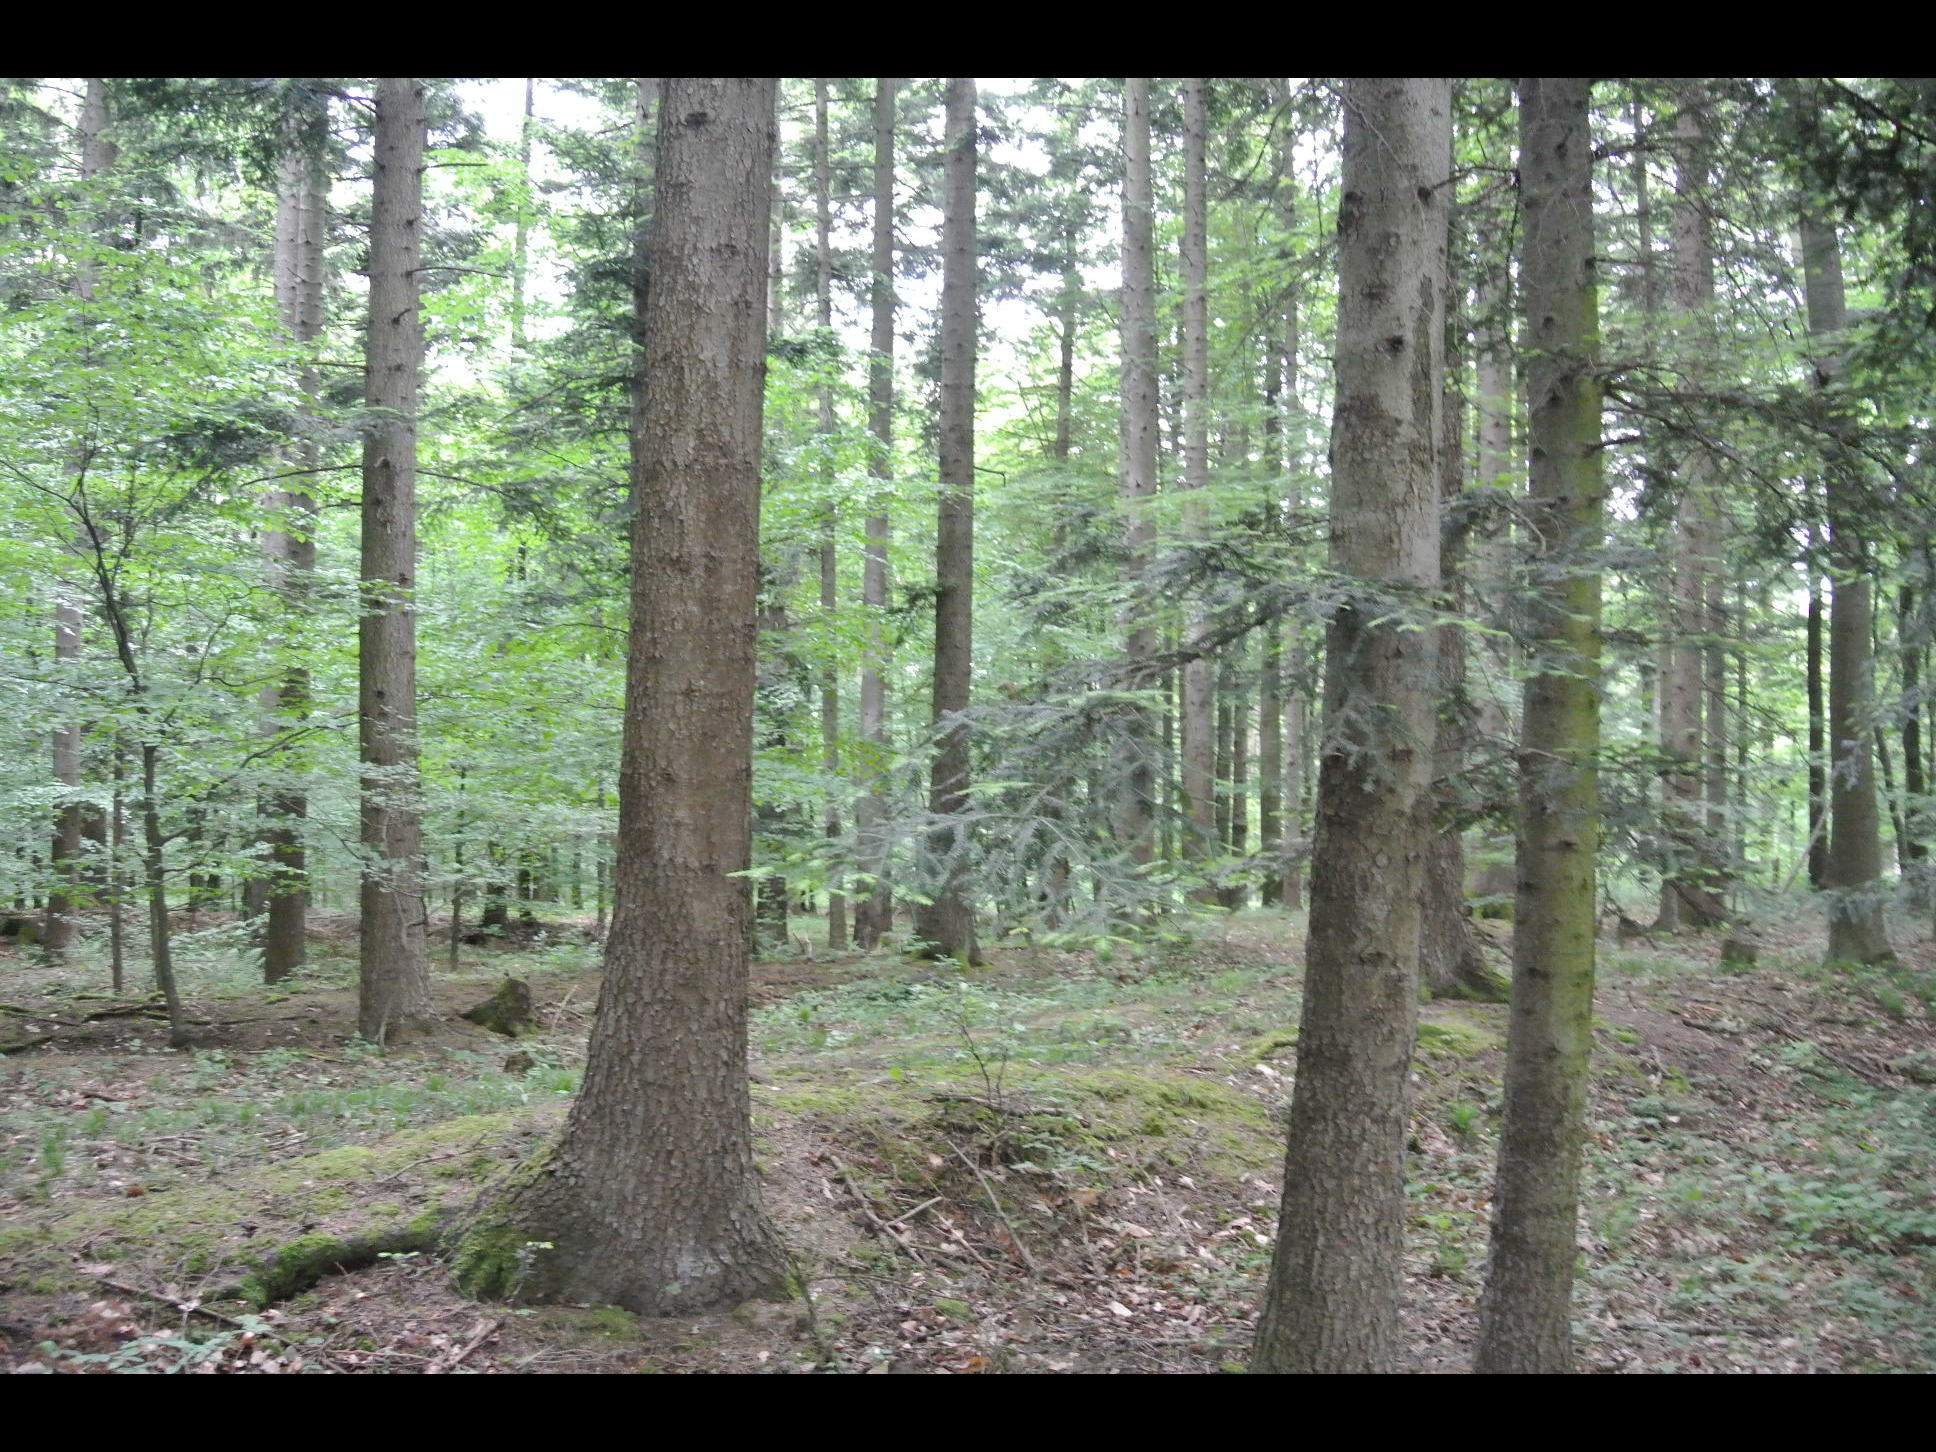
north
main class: Woodland
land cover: Other mixed woodland
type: mountainous beech forest
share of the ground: > 75 %
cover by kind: coniferous forest trees 60 %, broadleaved forest trees 40 %
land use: Forestry
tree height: > 5 m
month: May
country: AT
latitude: 48.1584
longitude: 15.8512
